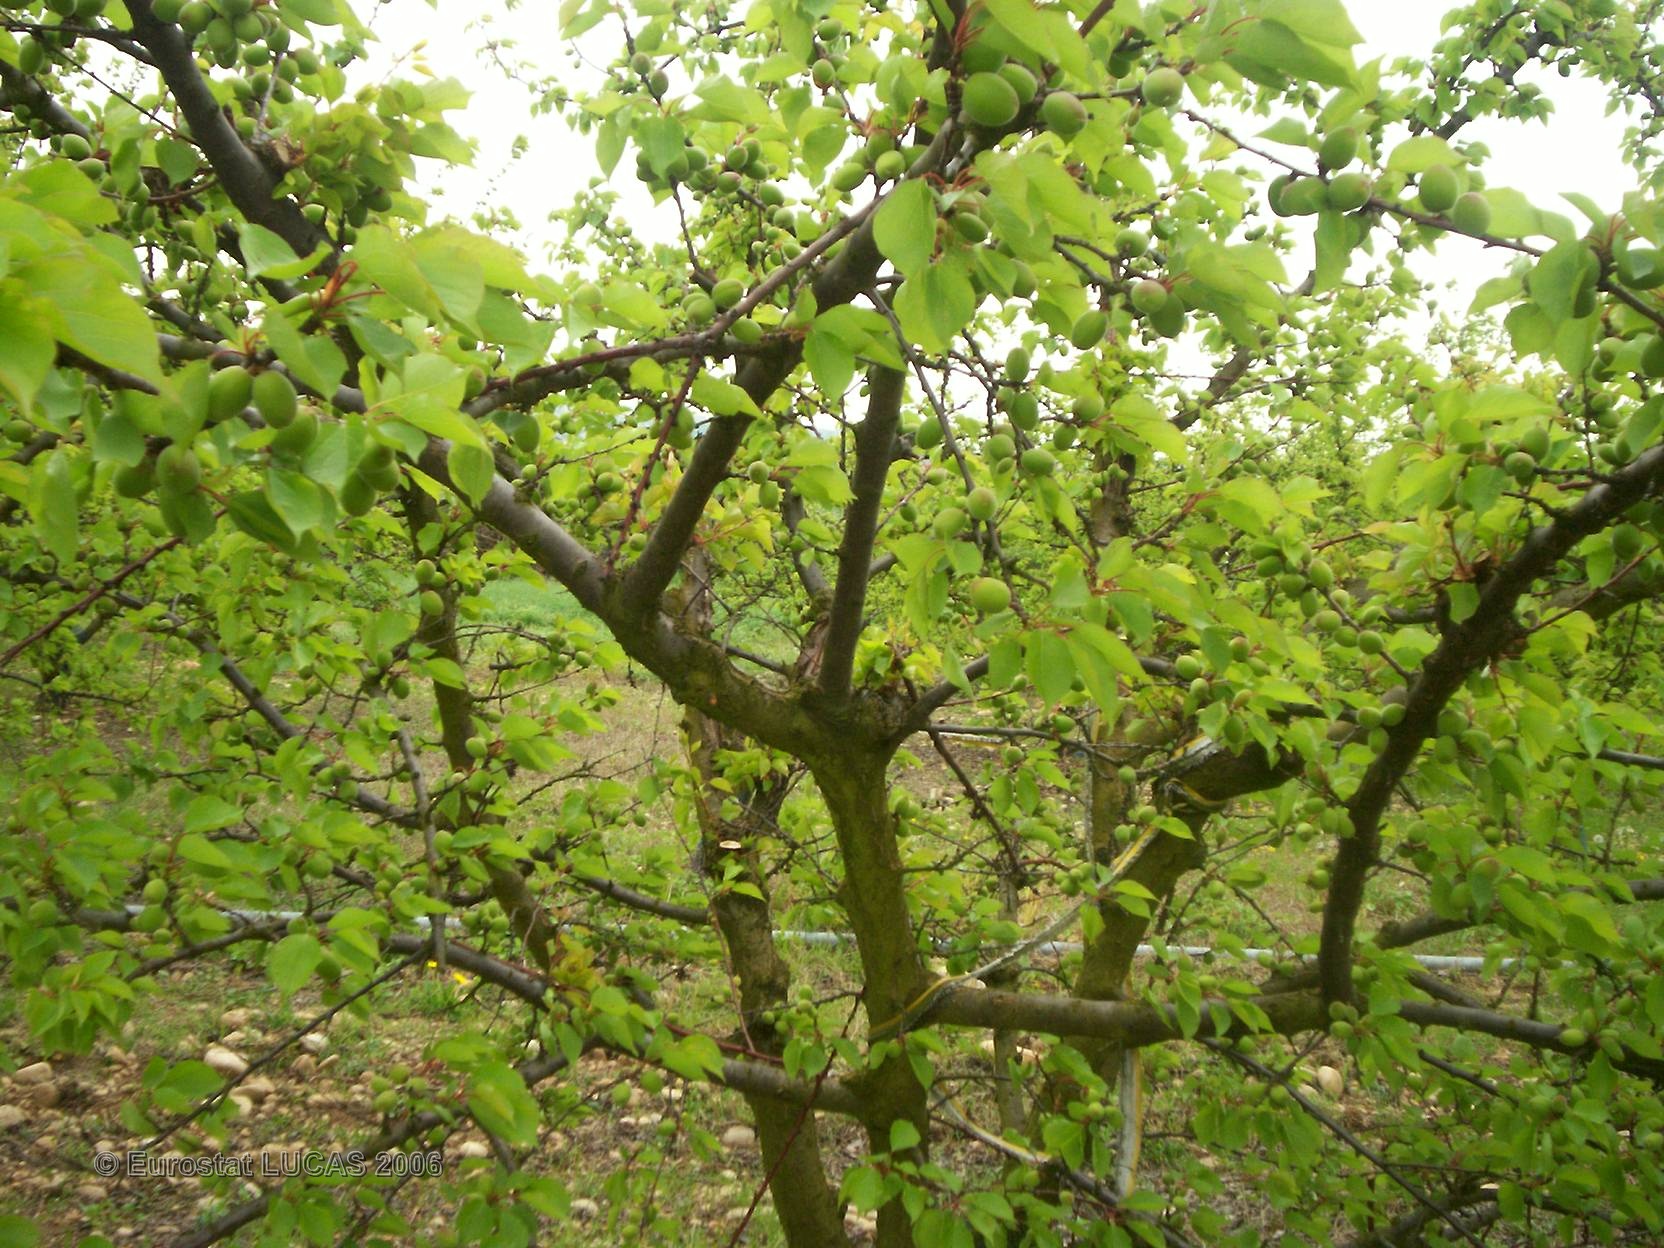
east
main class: Cropland
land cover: Other fruit trees and berries
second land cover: Grassland with sparse tree/shrub cover
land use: Agriculture (excluding fallow land and kitchen gardens)
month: April
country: FR
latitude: 45.3754
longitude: 4.7817
